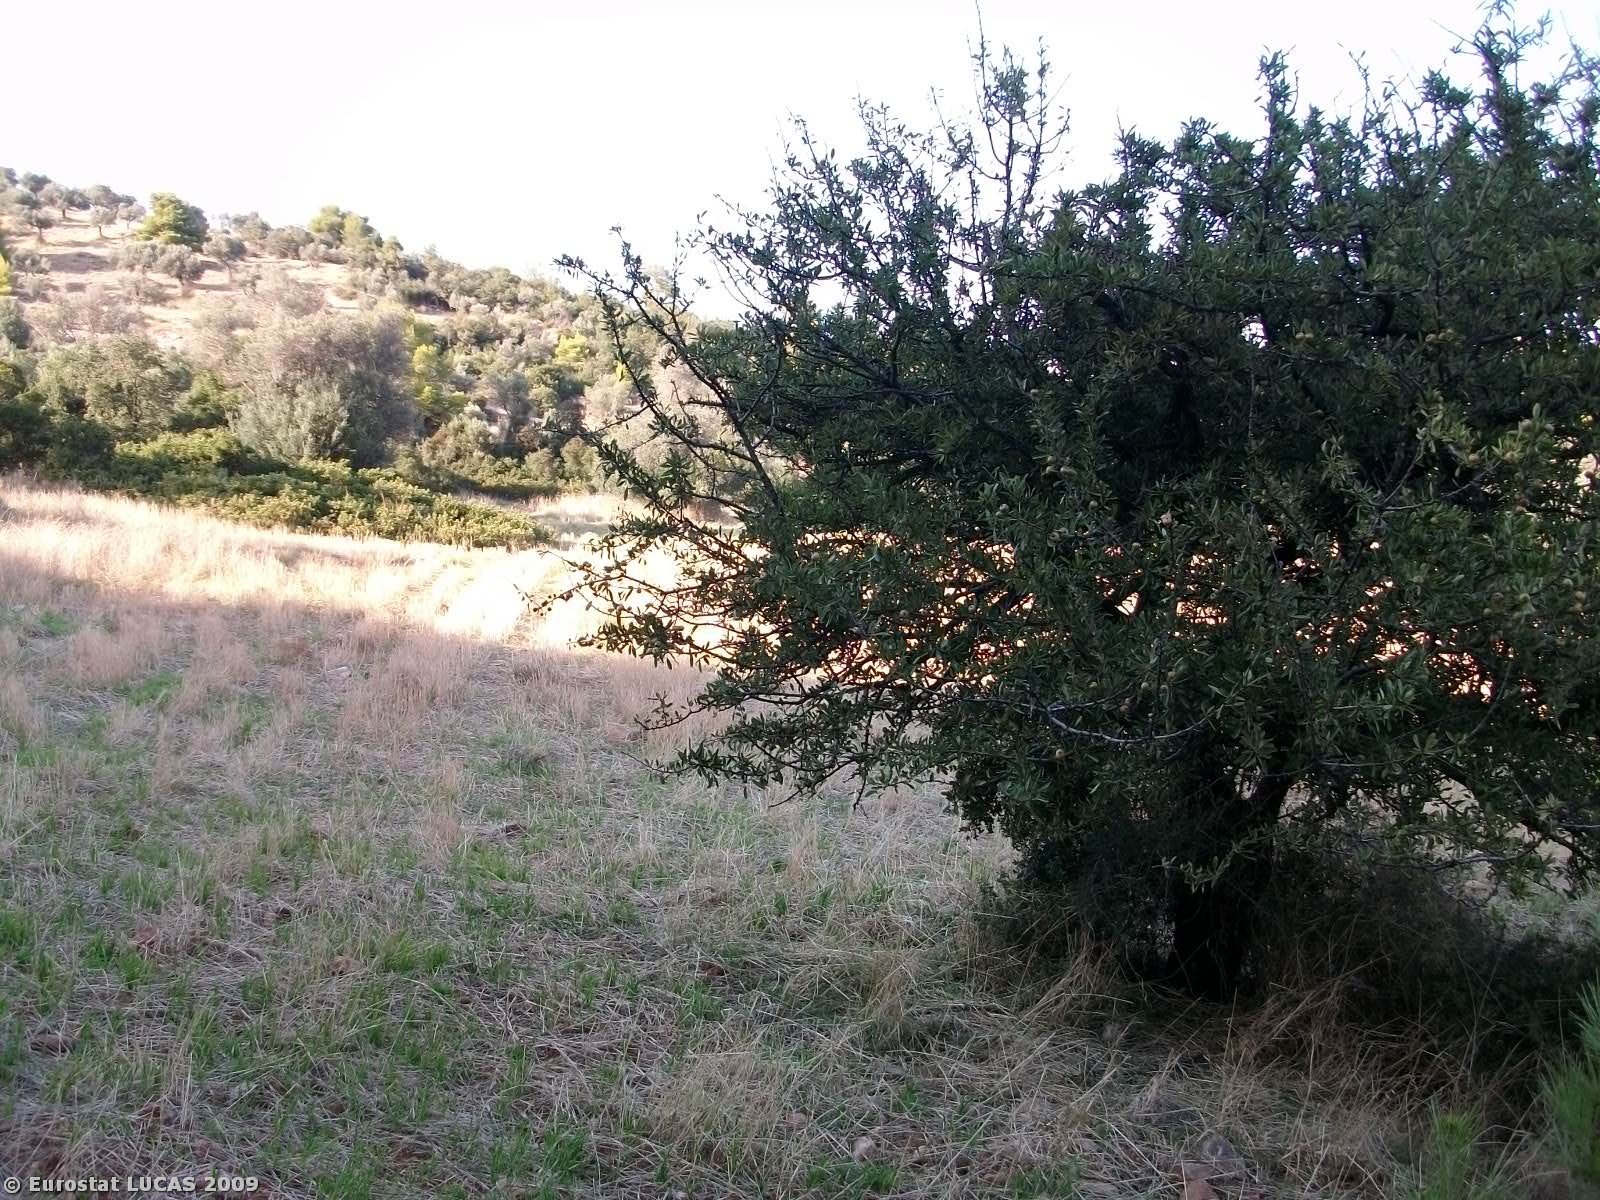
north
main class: Woodland
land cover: Mixed woodland
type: coniferous forest of the mediterranean region
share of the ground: > 75 %
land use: Forestry
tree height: > 5 m
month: September
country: GR
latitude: 38.2301
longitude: 24.0043
